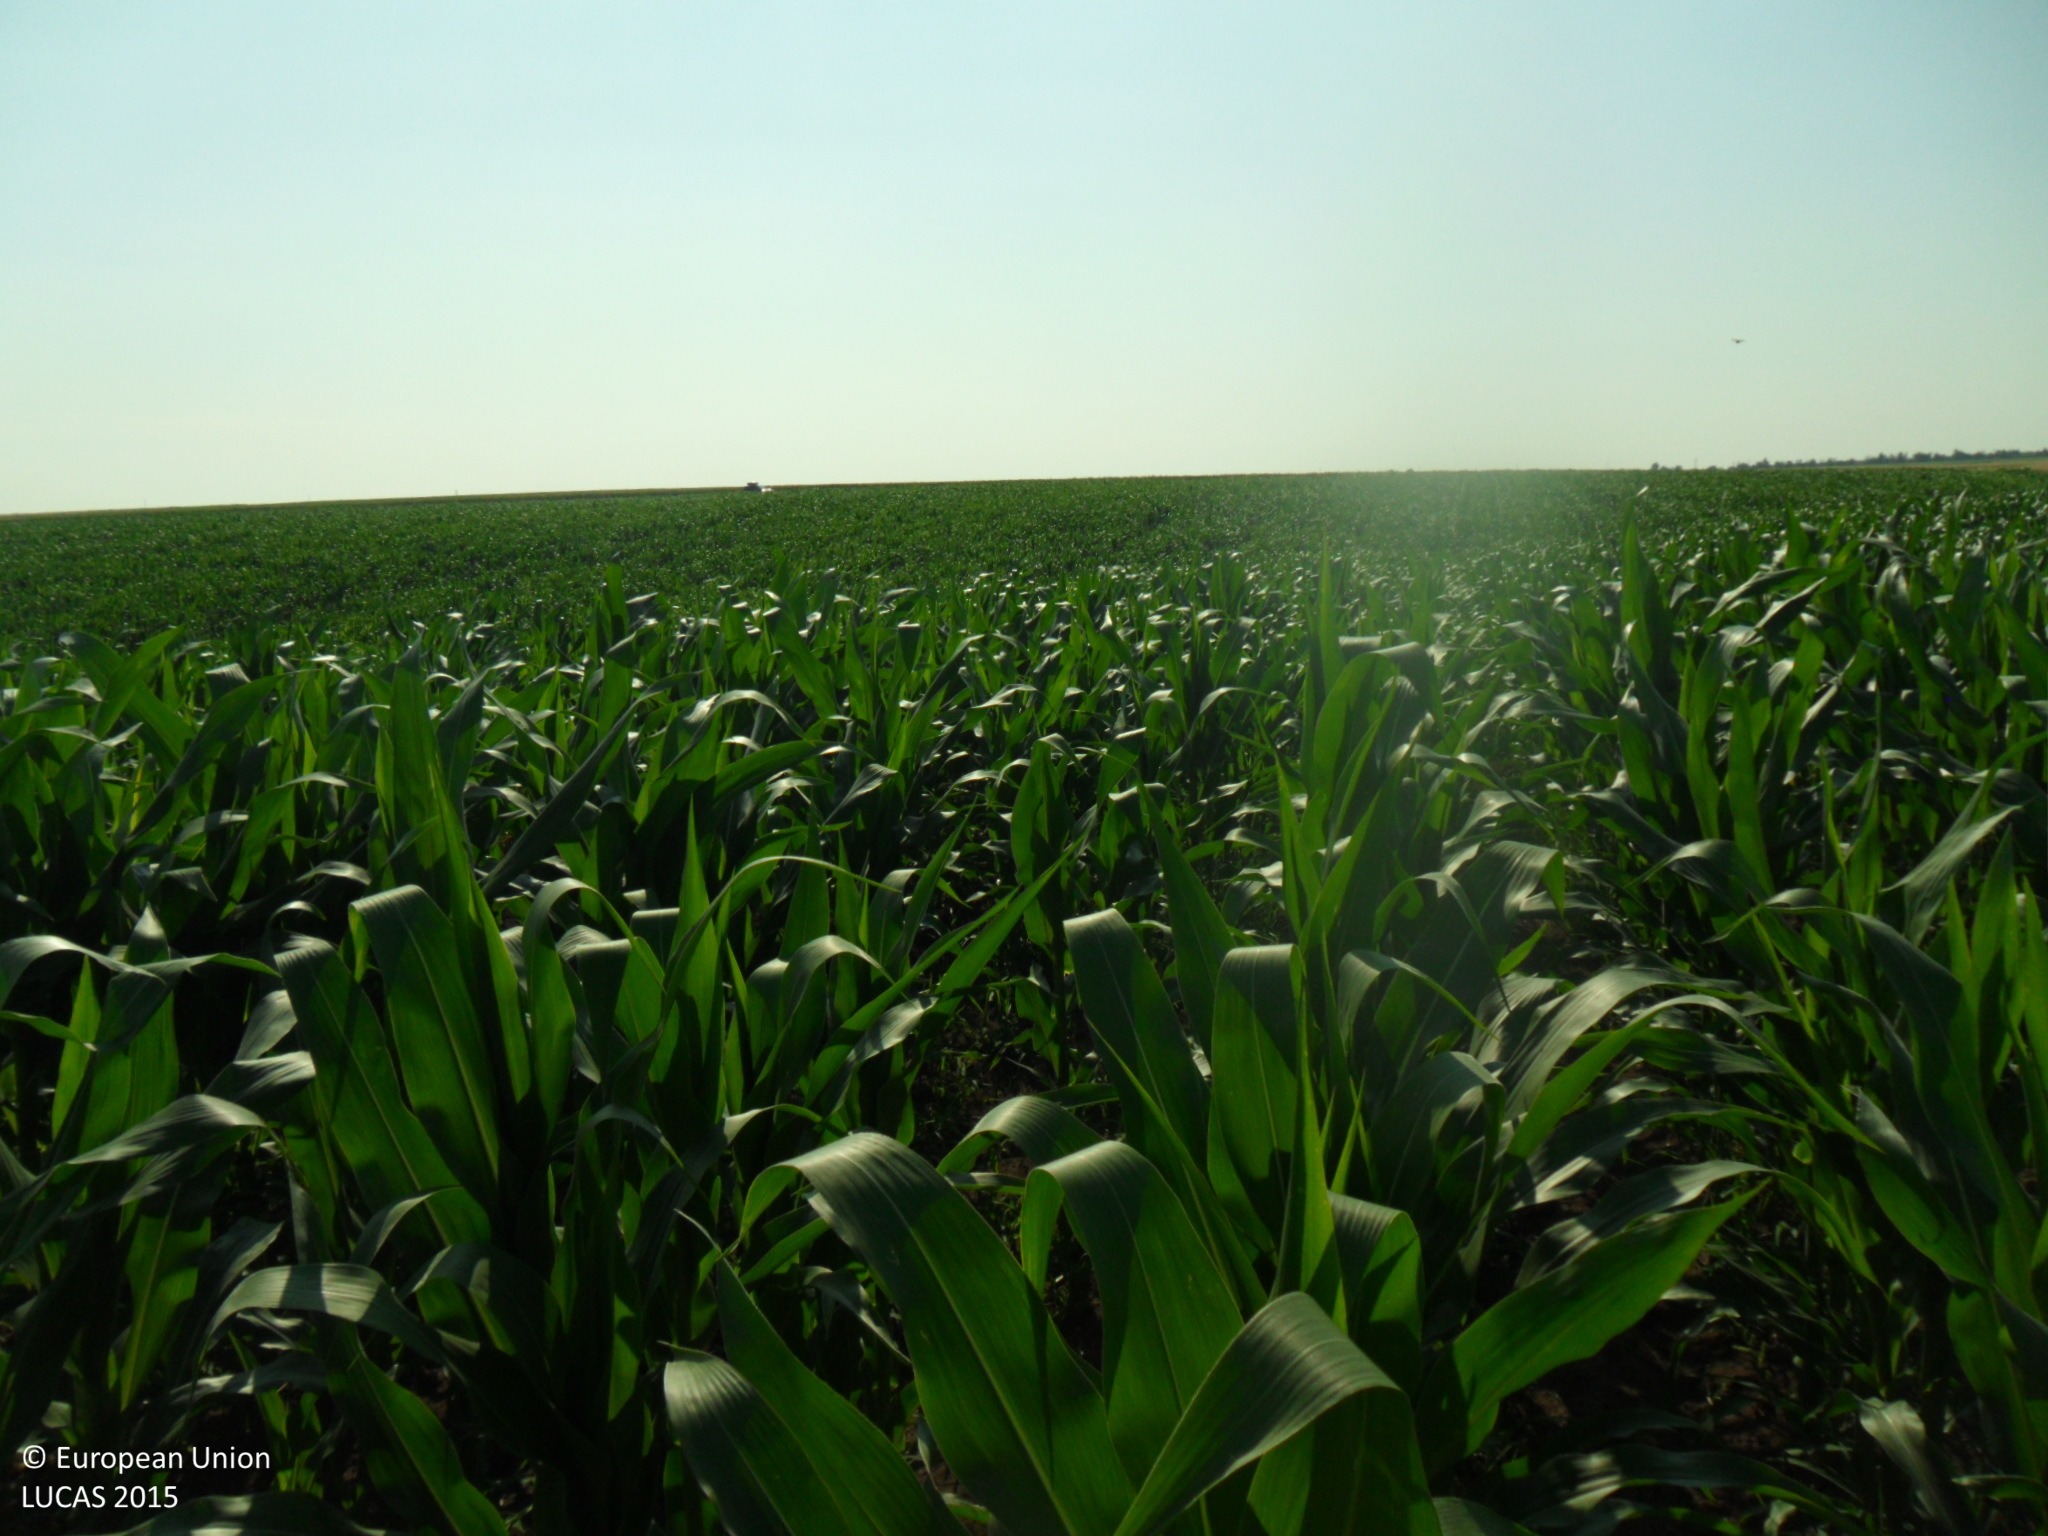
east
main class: Cropland
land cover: Maize
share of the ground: > 75 %
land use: Agriculture (excluding fallow land and kitchen gardens)
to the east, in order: Maize; Tracks; Sunflower
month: July
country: BG
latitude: 43.6417
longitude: 26.7359
